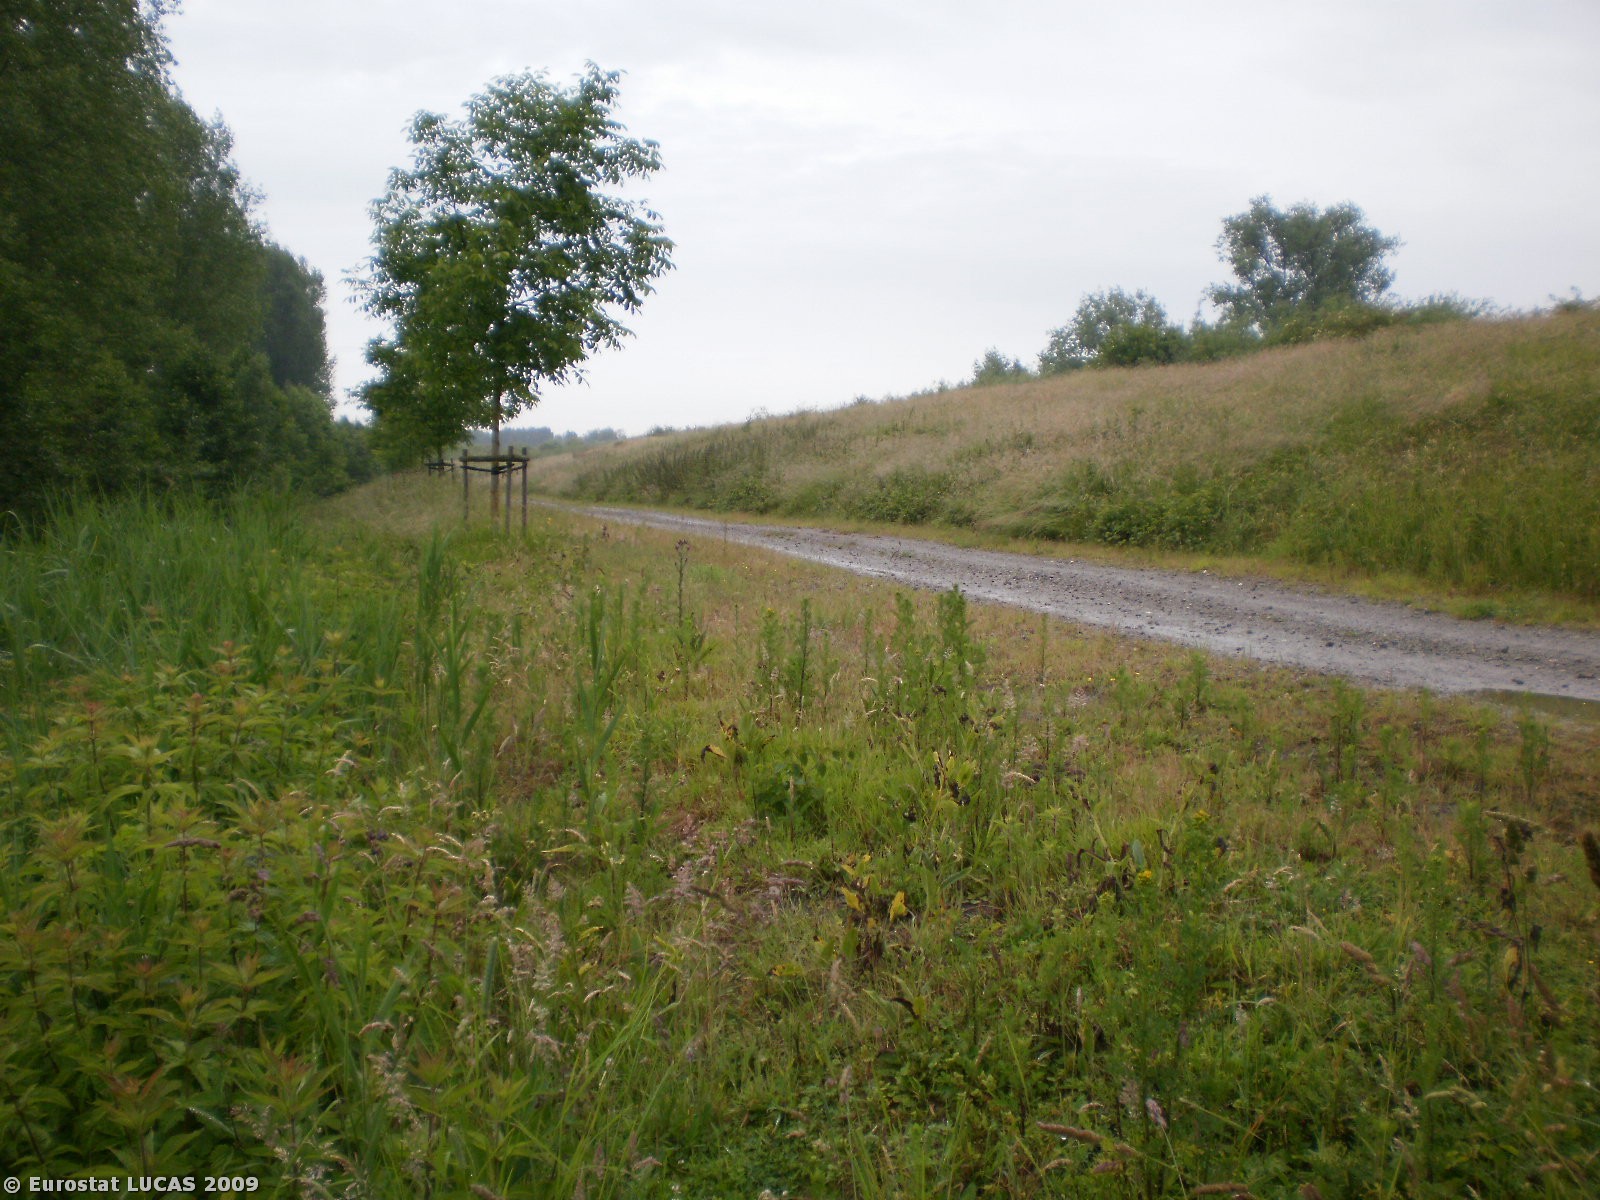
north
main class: Grassland
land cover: Grassland with sparse tree/shrub cover
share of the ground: > 75 %
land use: Nature reserves
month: June
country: BE
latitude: 51.0814
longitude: 4.1849
